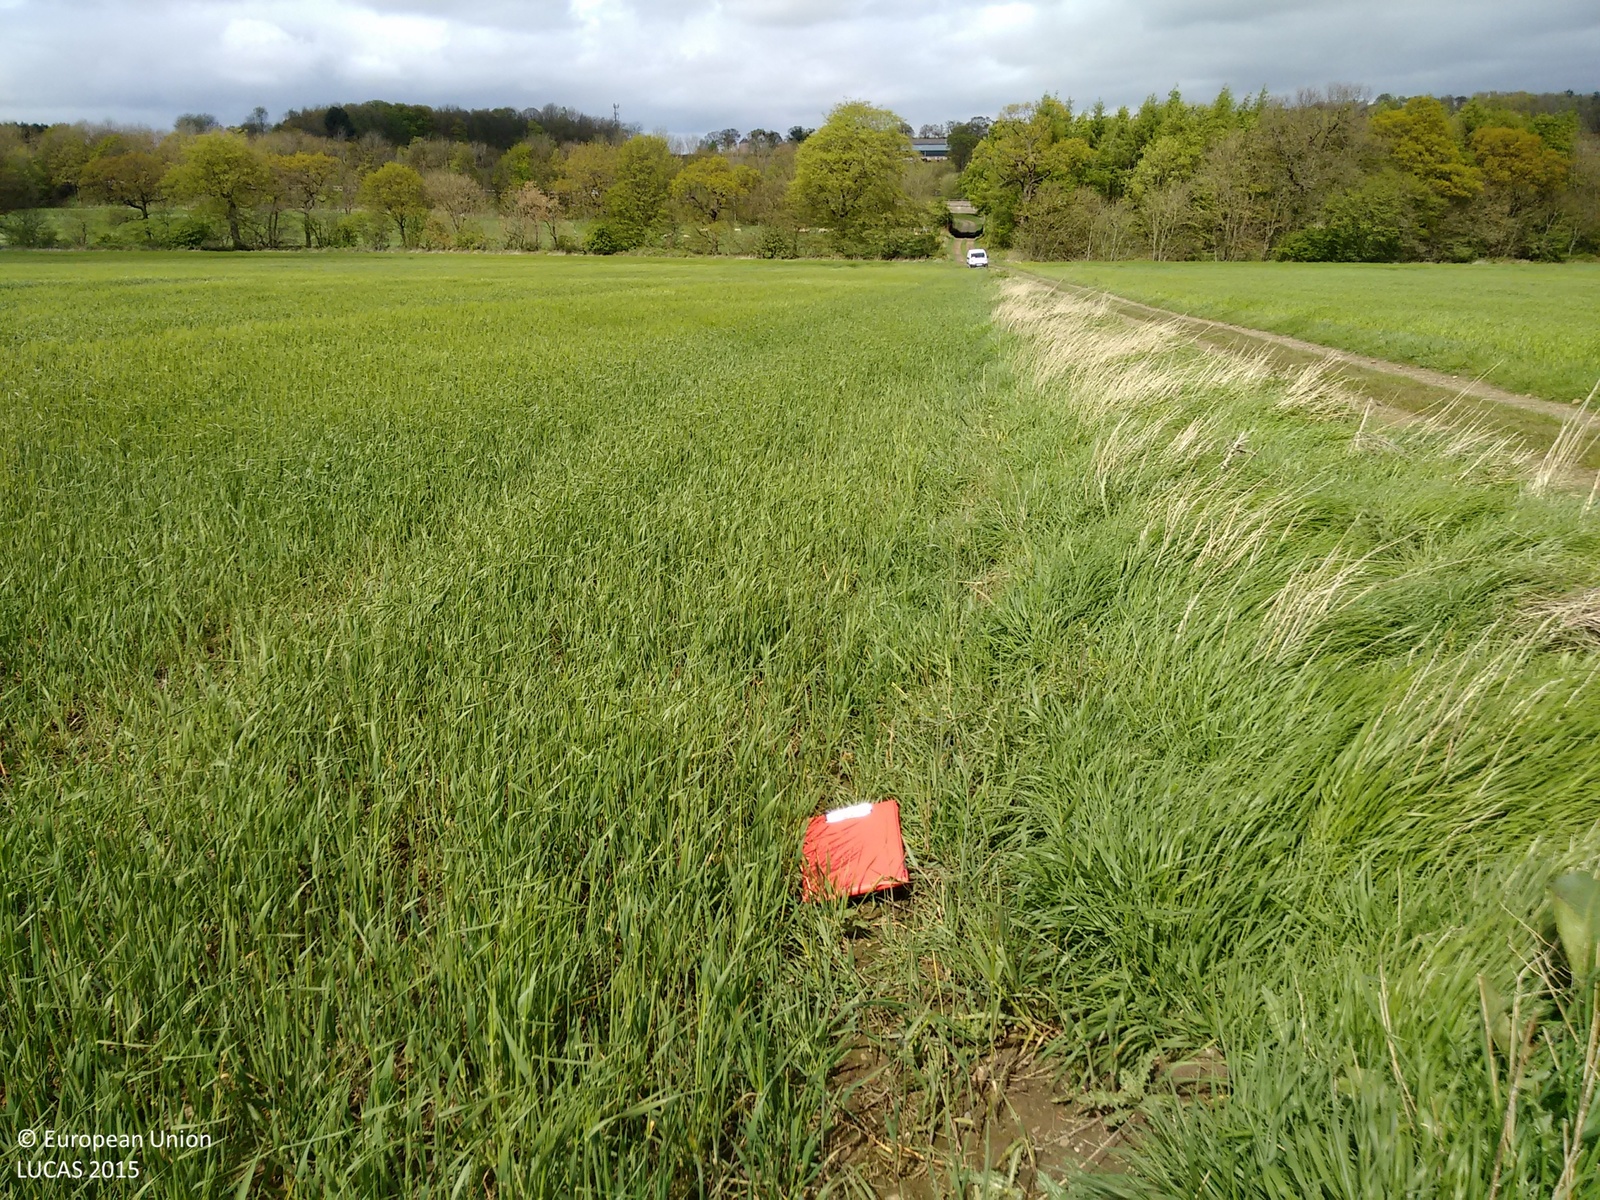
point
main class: Cropland
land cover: Barley
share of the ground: > 75 %
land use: Agriculture (excluding fallow land and kitchen gardens)
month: May
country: GB
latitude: 55.9778
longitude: -3.3597
